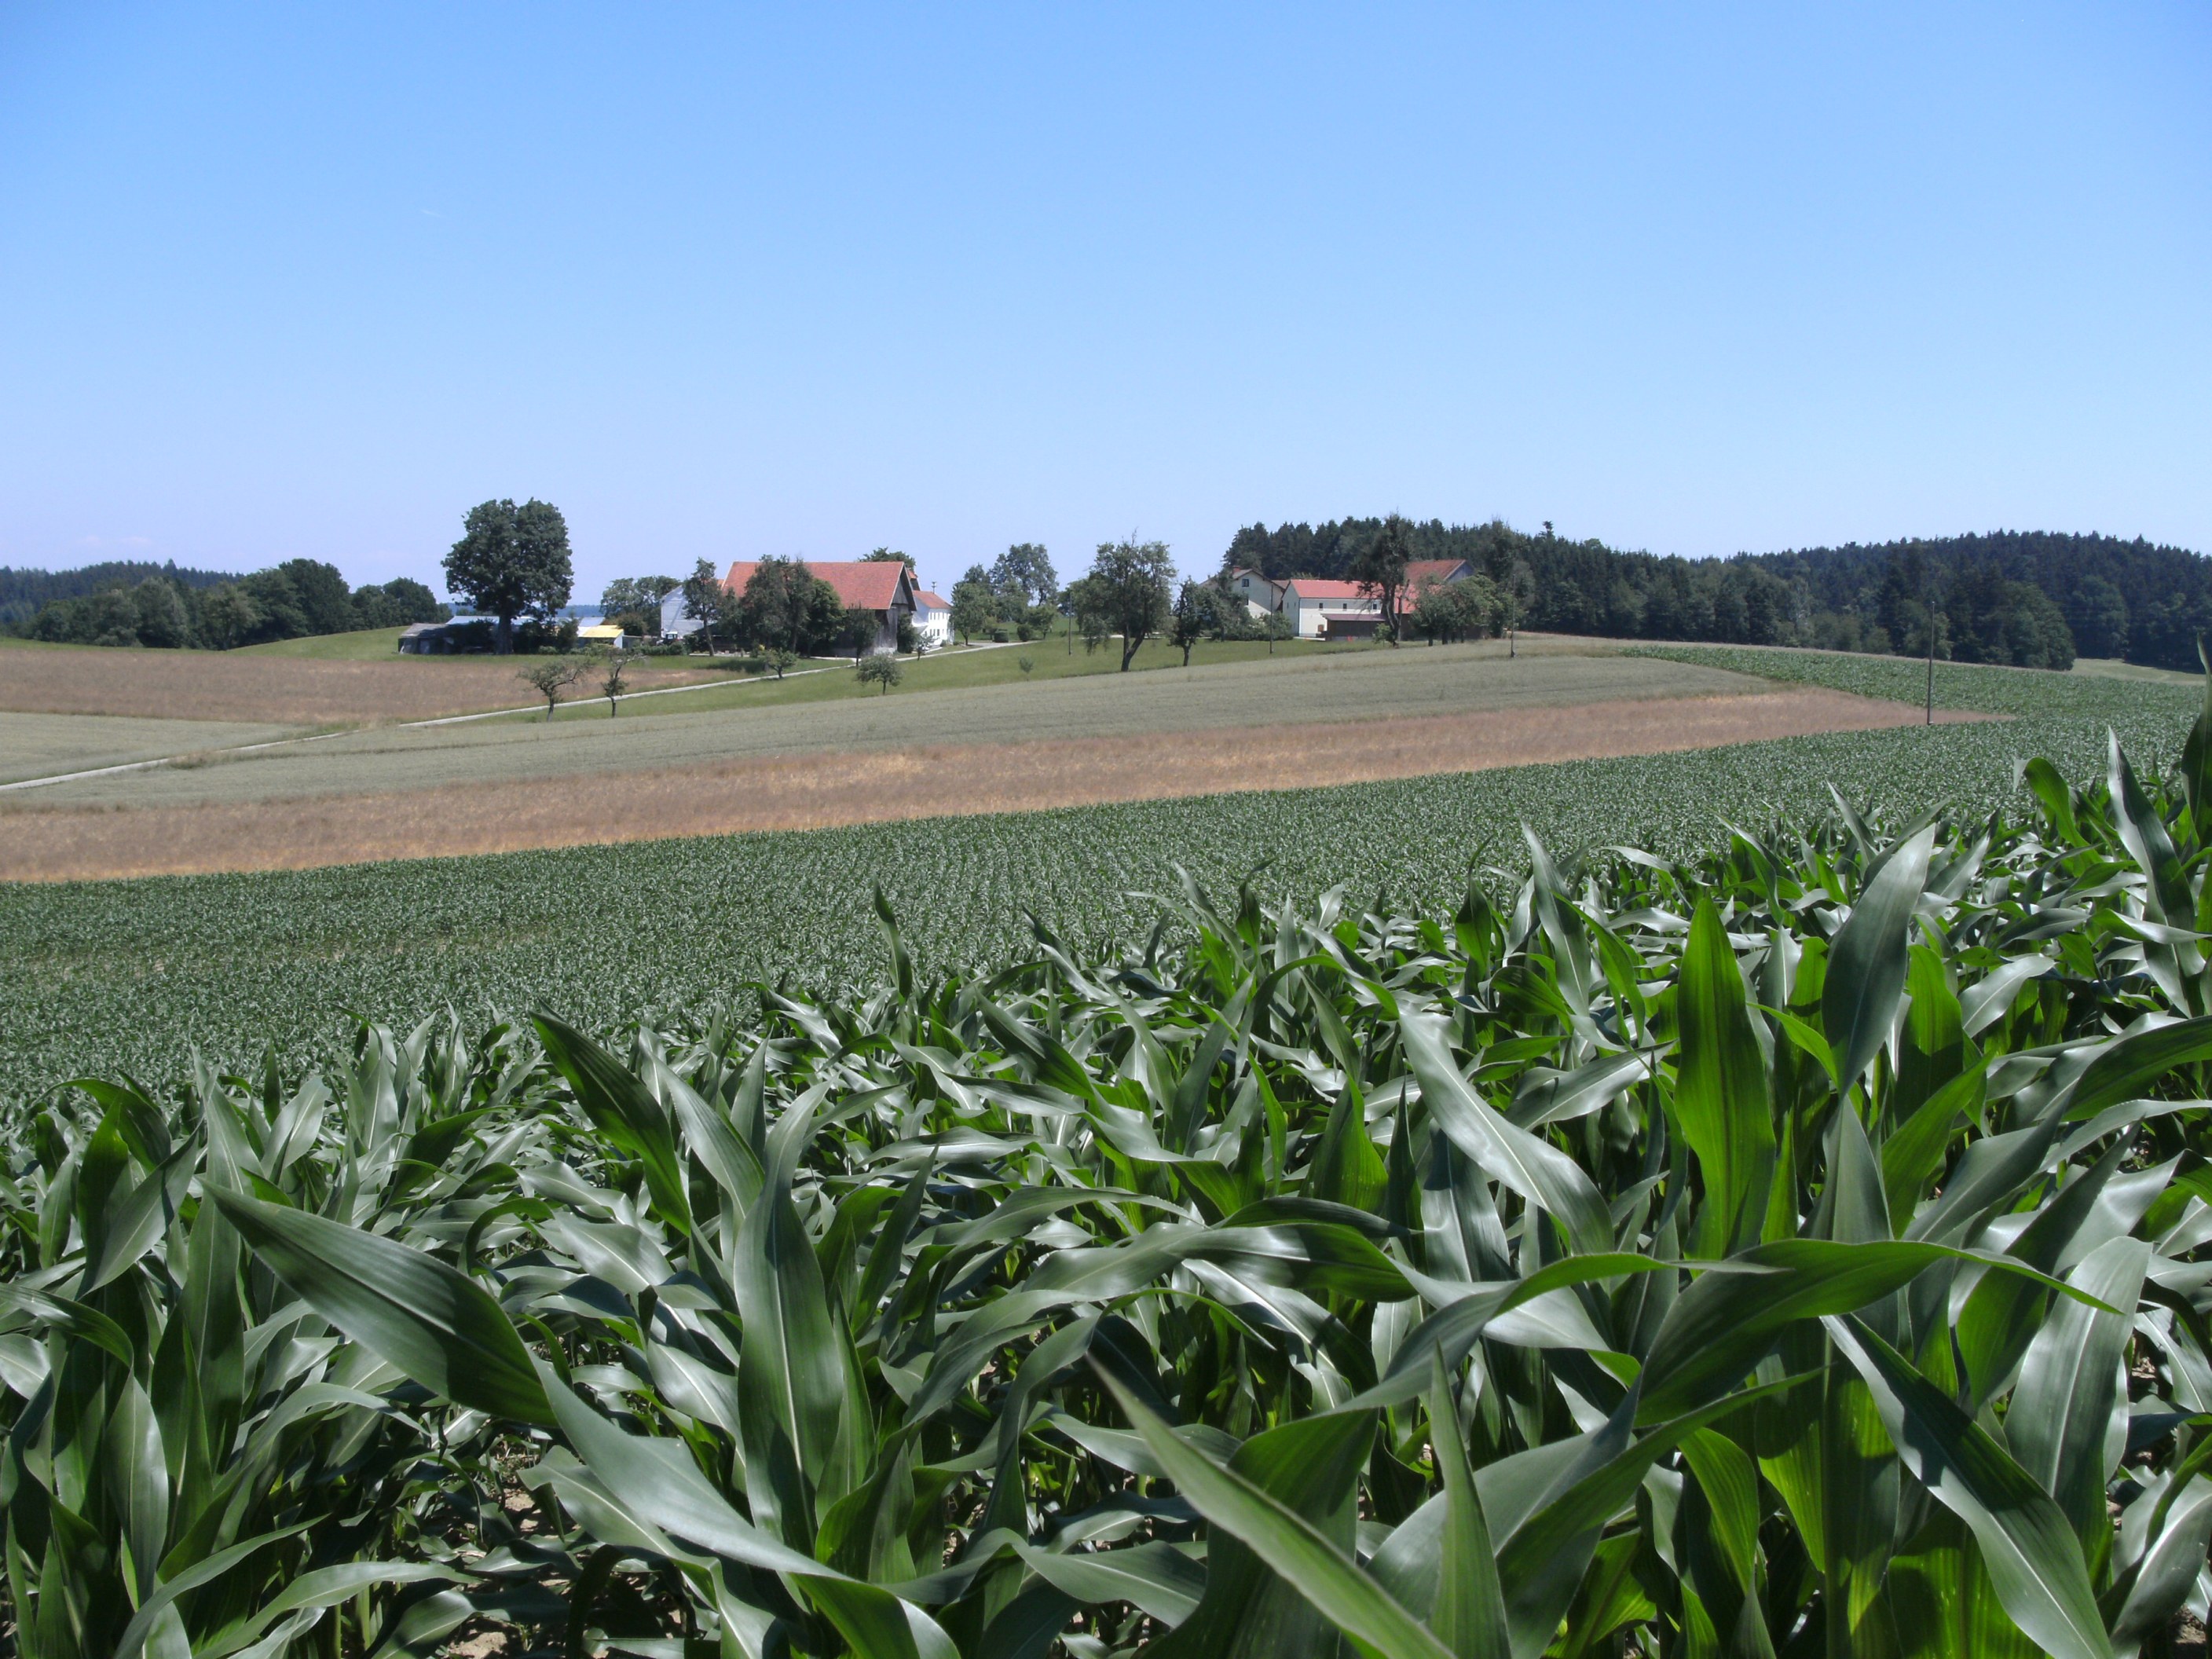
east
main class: Cropland
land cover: Maize
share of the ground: > 75 %
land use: Agriculture (excluding fallow land and kitchen gardens)
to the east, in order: Maize; Grass margins; Barley; Common wheat; Grass margins; Common wheat; Apple fruit; Grassland without tree/shrub cover
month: July
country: AT
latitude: 48.2430
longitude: 13.4061
